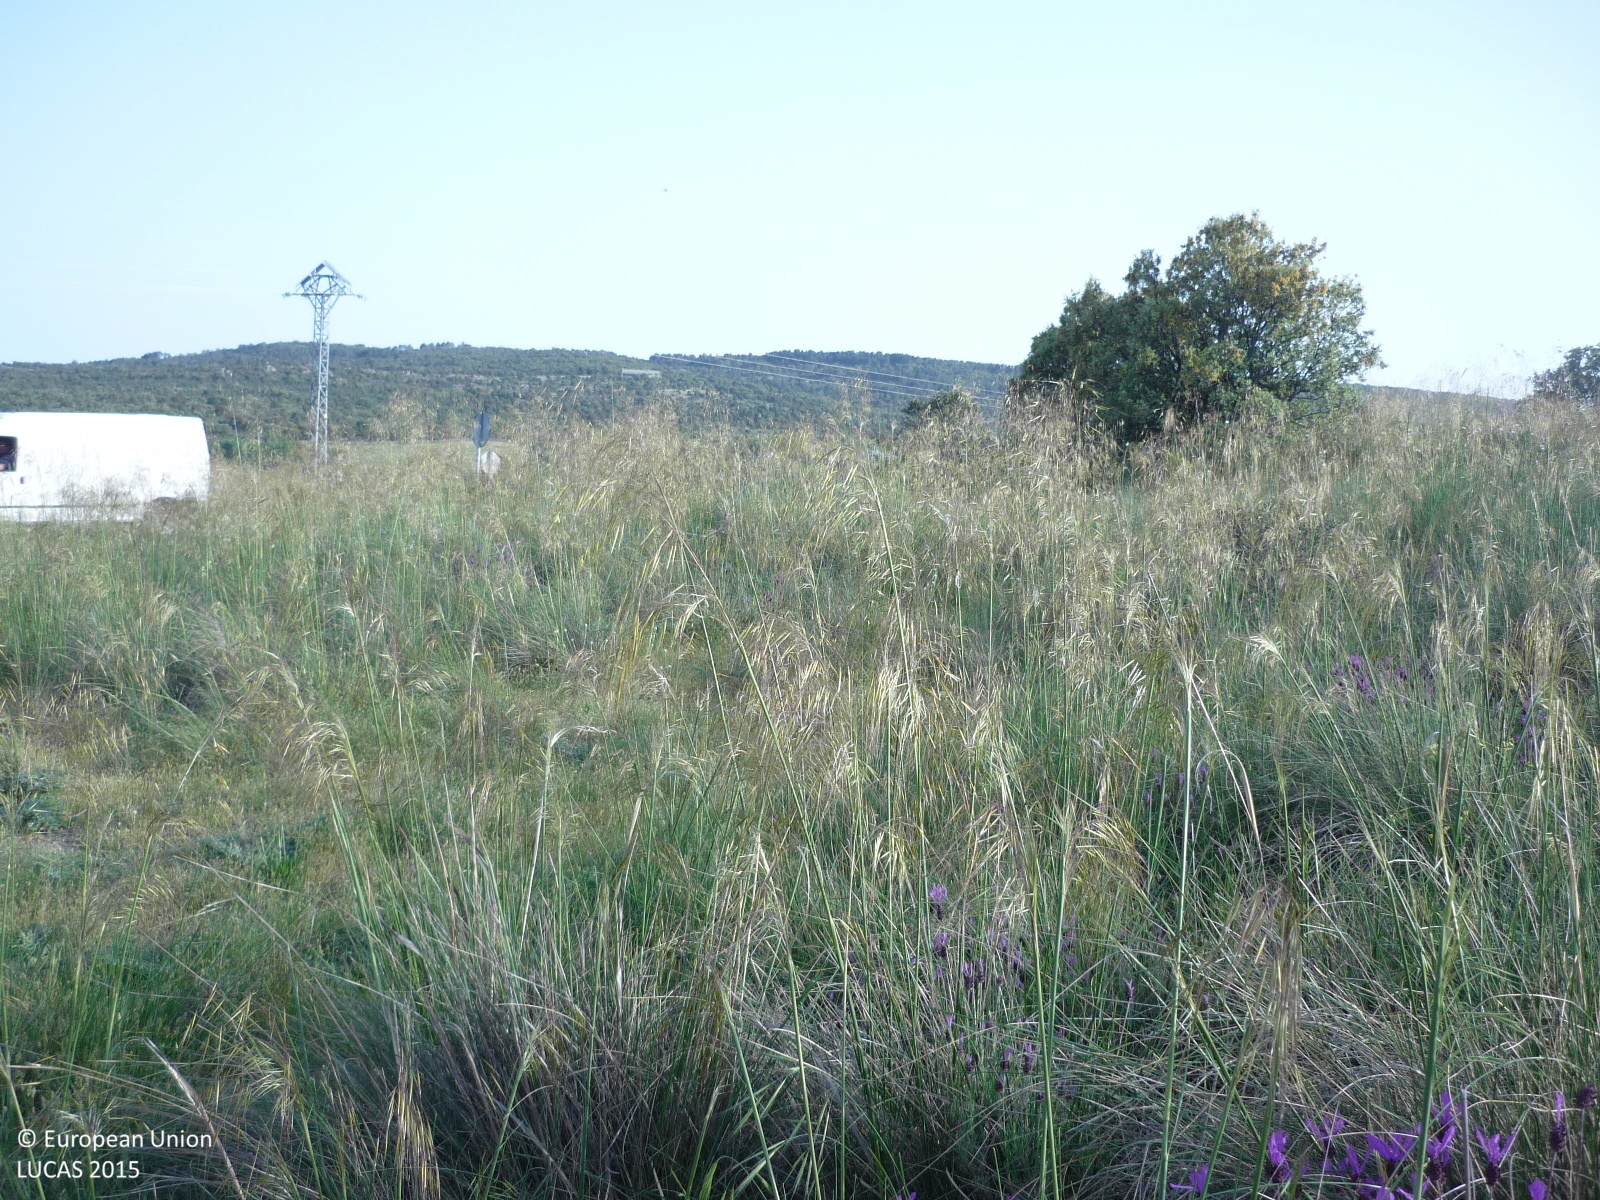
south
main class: Grassland
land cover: Grassland with sparse tree/shrub cover
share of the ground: > 75 %
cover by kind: herbaceous plants 85 %, shrubs 10 %, broadleaved forest trees 5 %
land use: Agriculture (excluding fallow land and kitchen gardens)
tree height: < 5 m
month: May
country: ES
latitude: 40.7224
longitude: -3.8837
